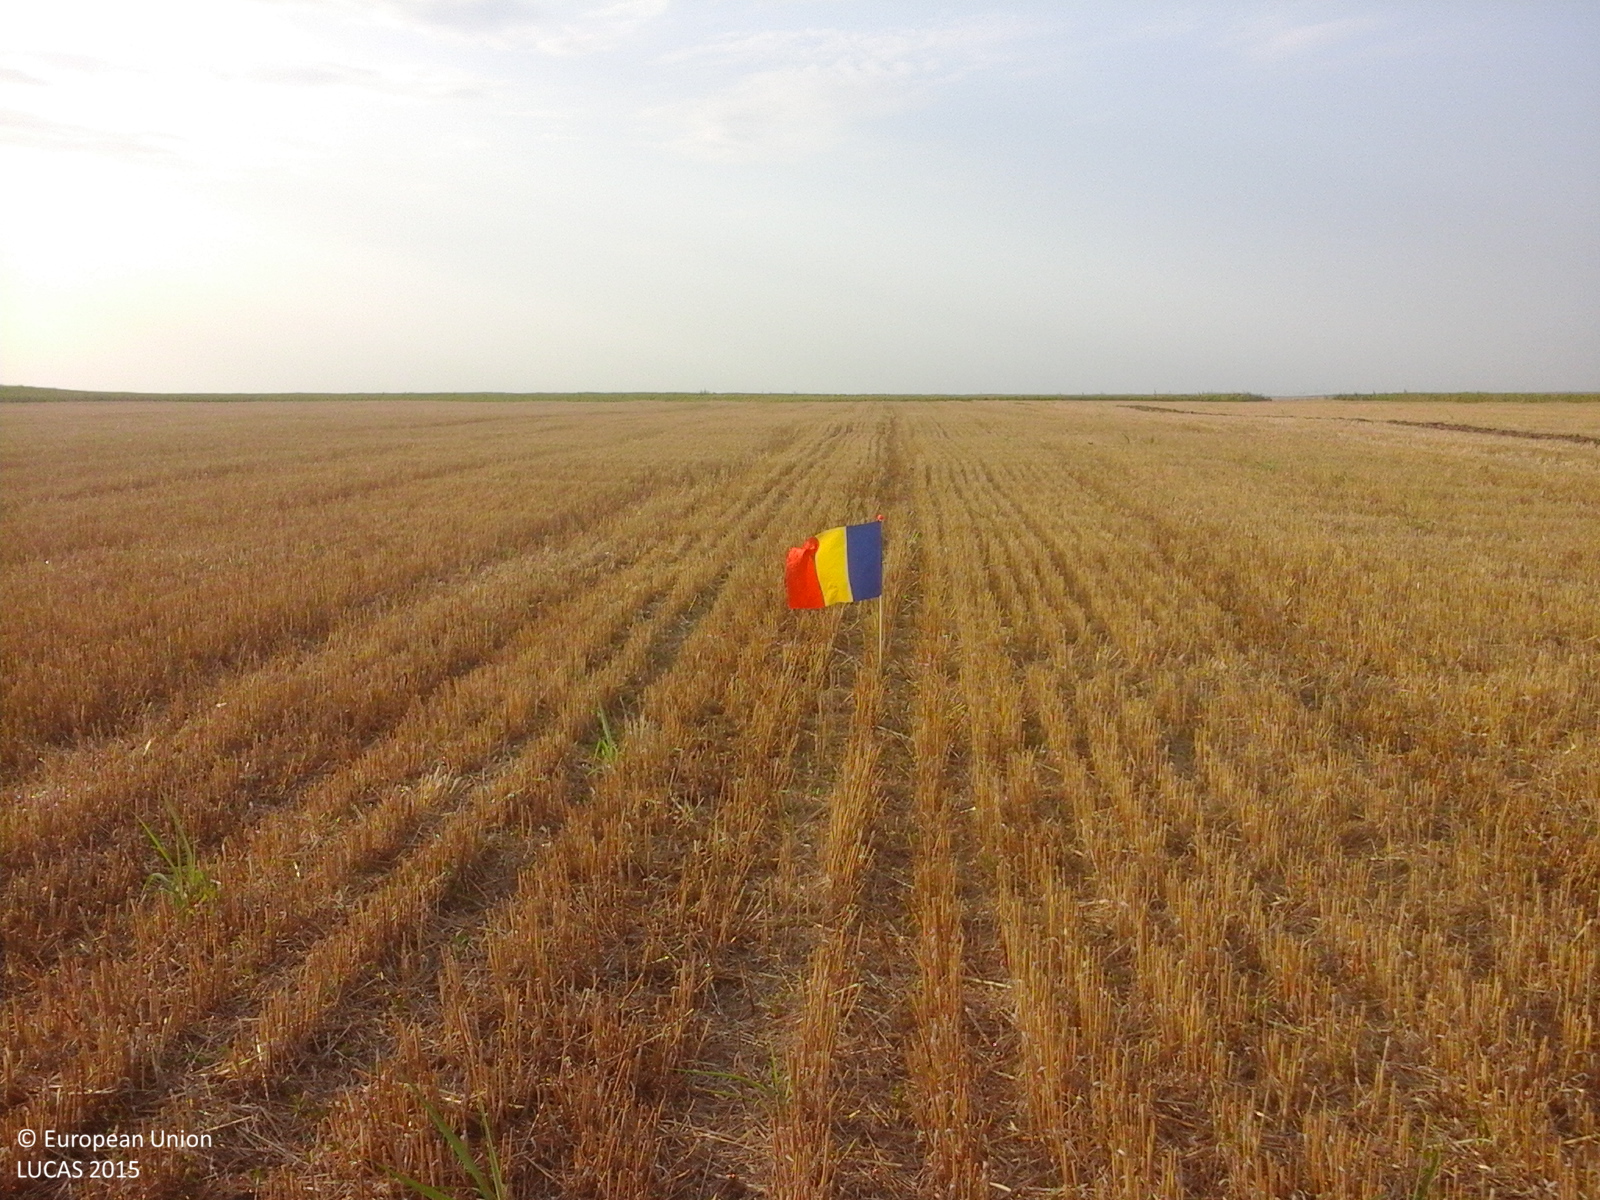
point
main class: Cropland
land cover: Barley
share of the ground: > 75 %
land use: Agriculture (excluding fallow land and kitchen gardens)
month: August
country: RO
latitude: 44.0406
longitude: 28.0622
